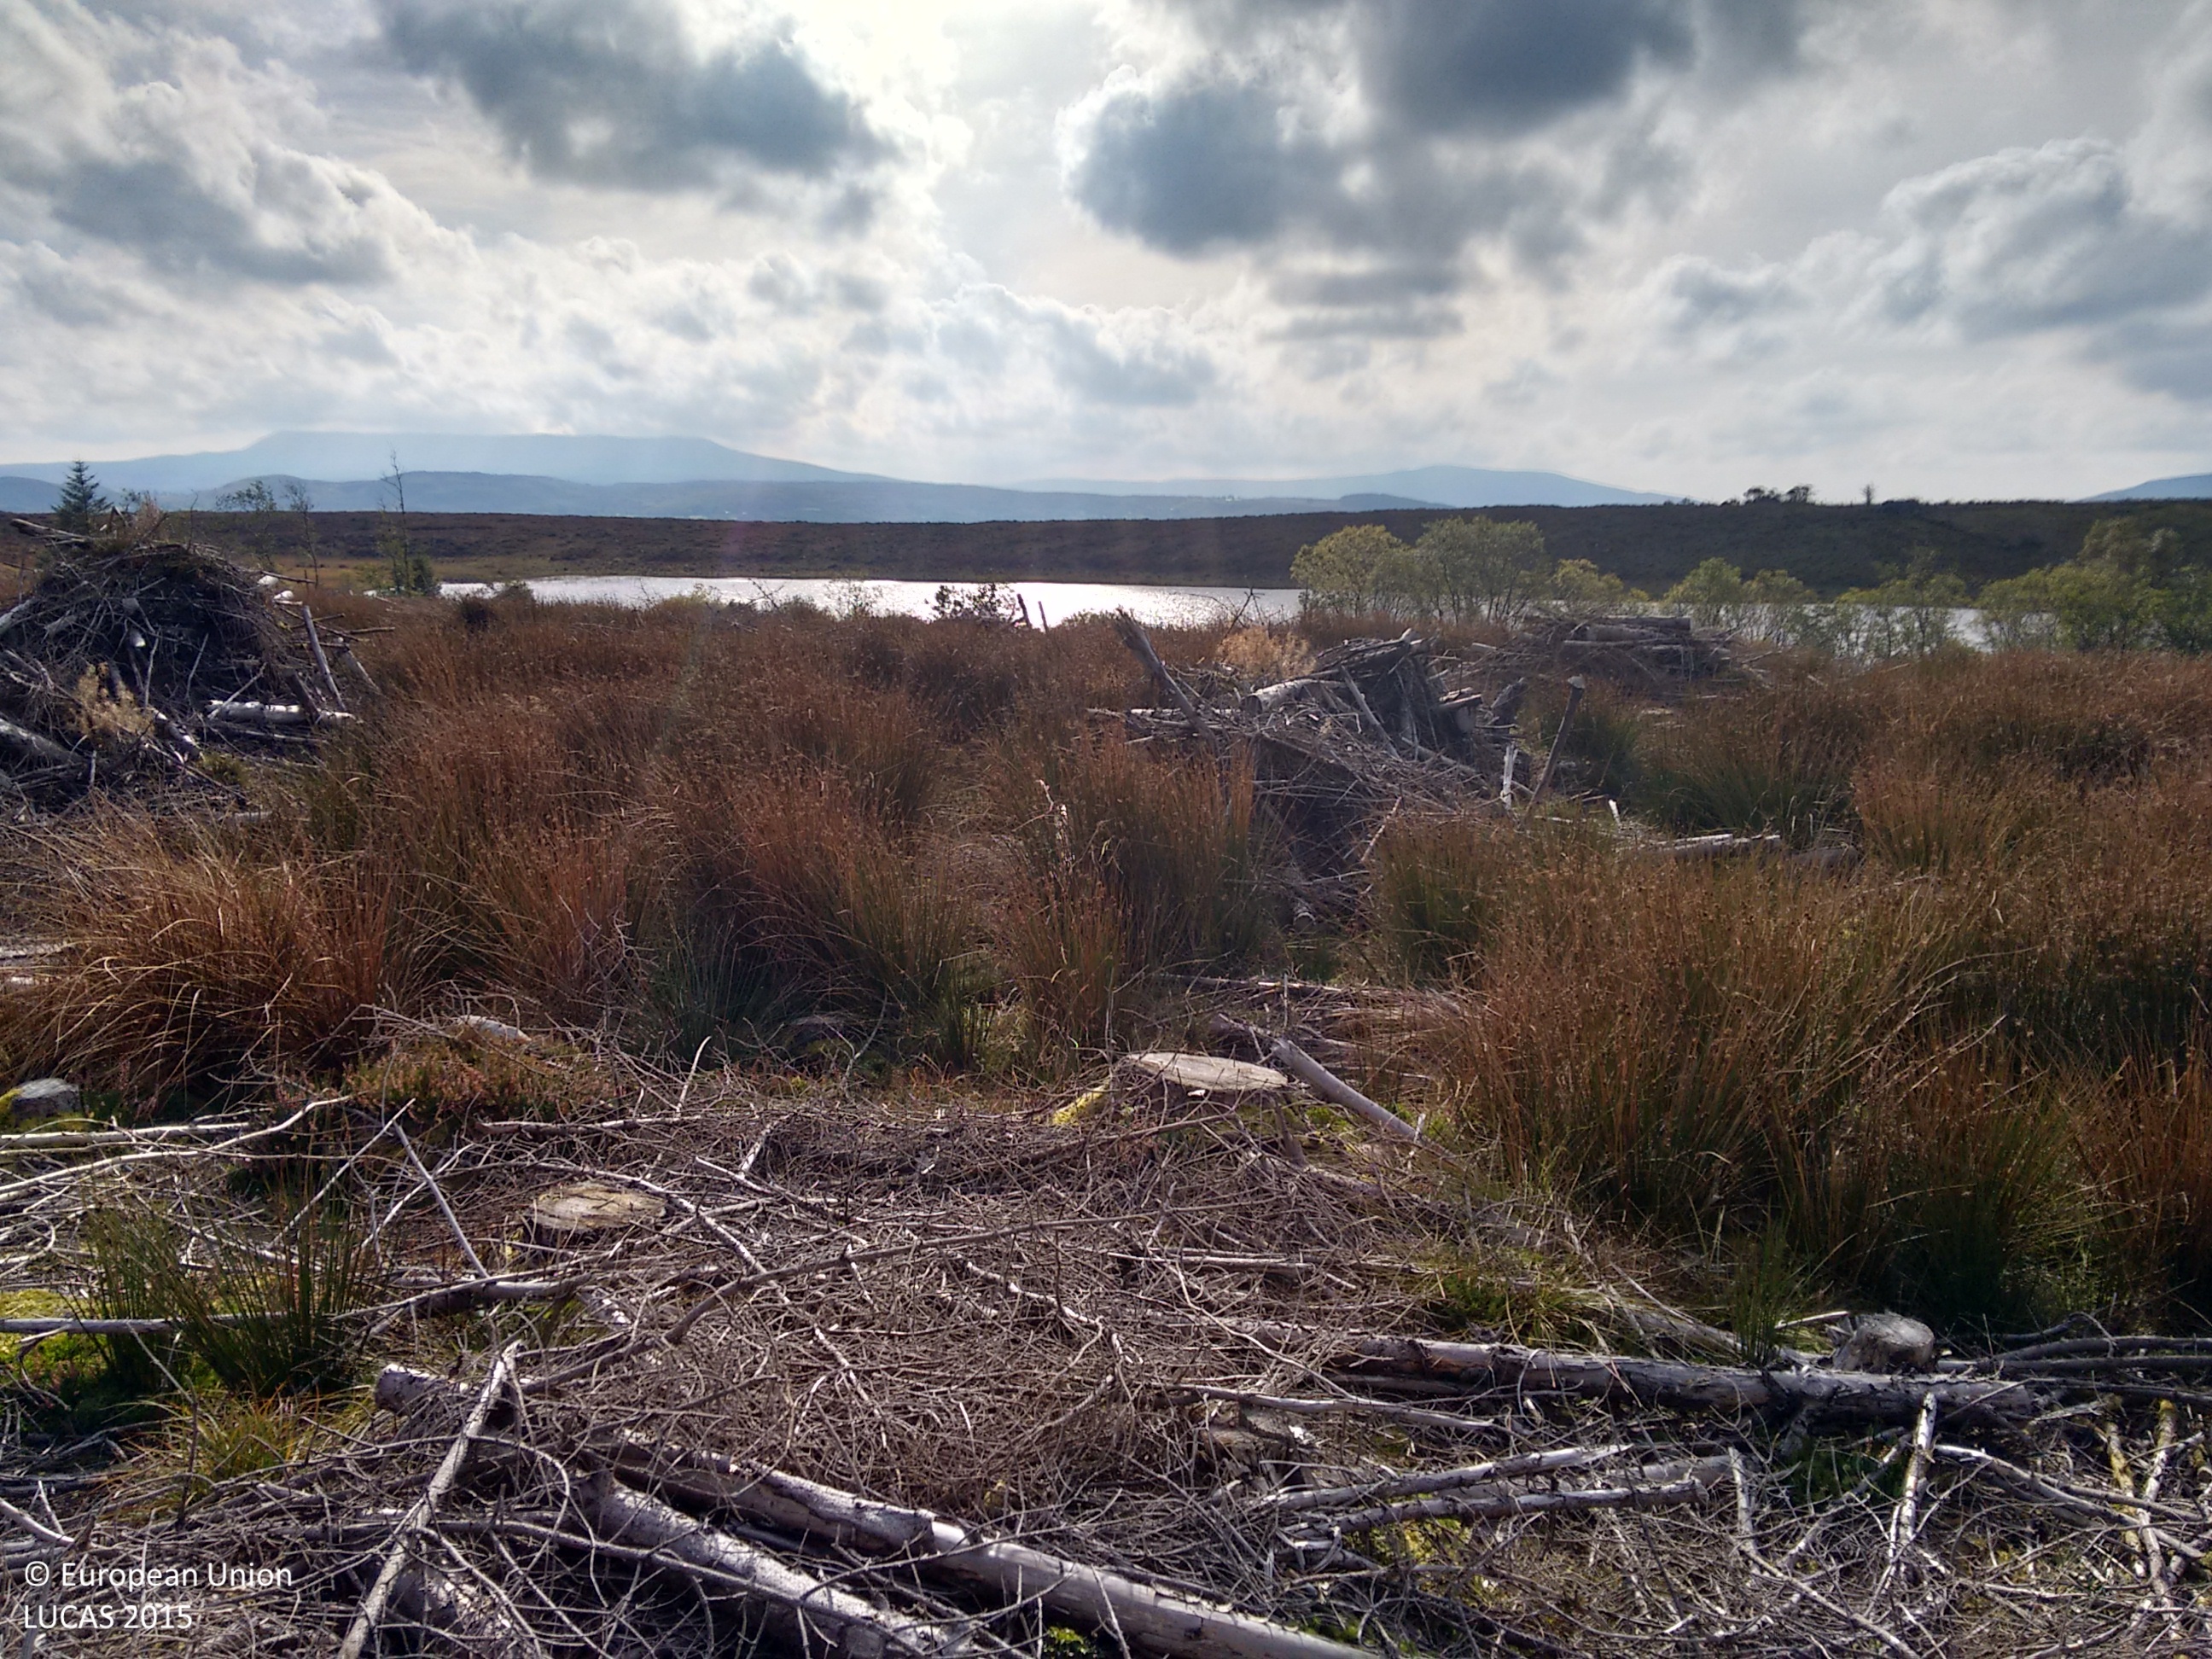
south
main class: Grassland
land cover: Grassland without tree/shrub cover
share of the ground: > 75 %
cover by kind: herbaceous plants 55 %, unconsolidated bare surface 25 %, lichens and mosses 20 %
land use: Forestry
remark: Clear cut
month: October
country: GB
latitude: 54.3222
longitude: -7.8968
